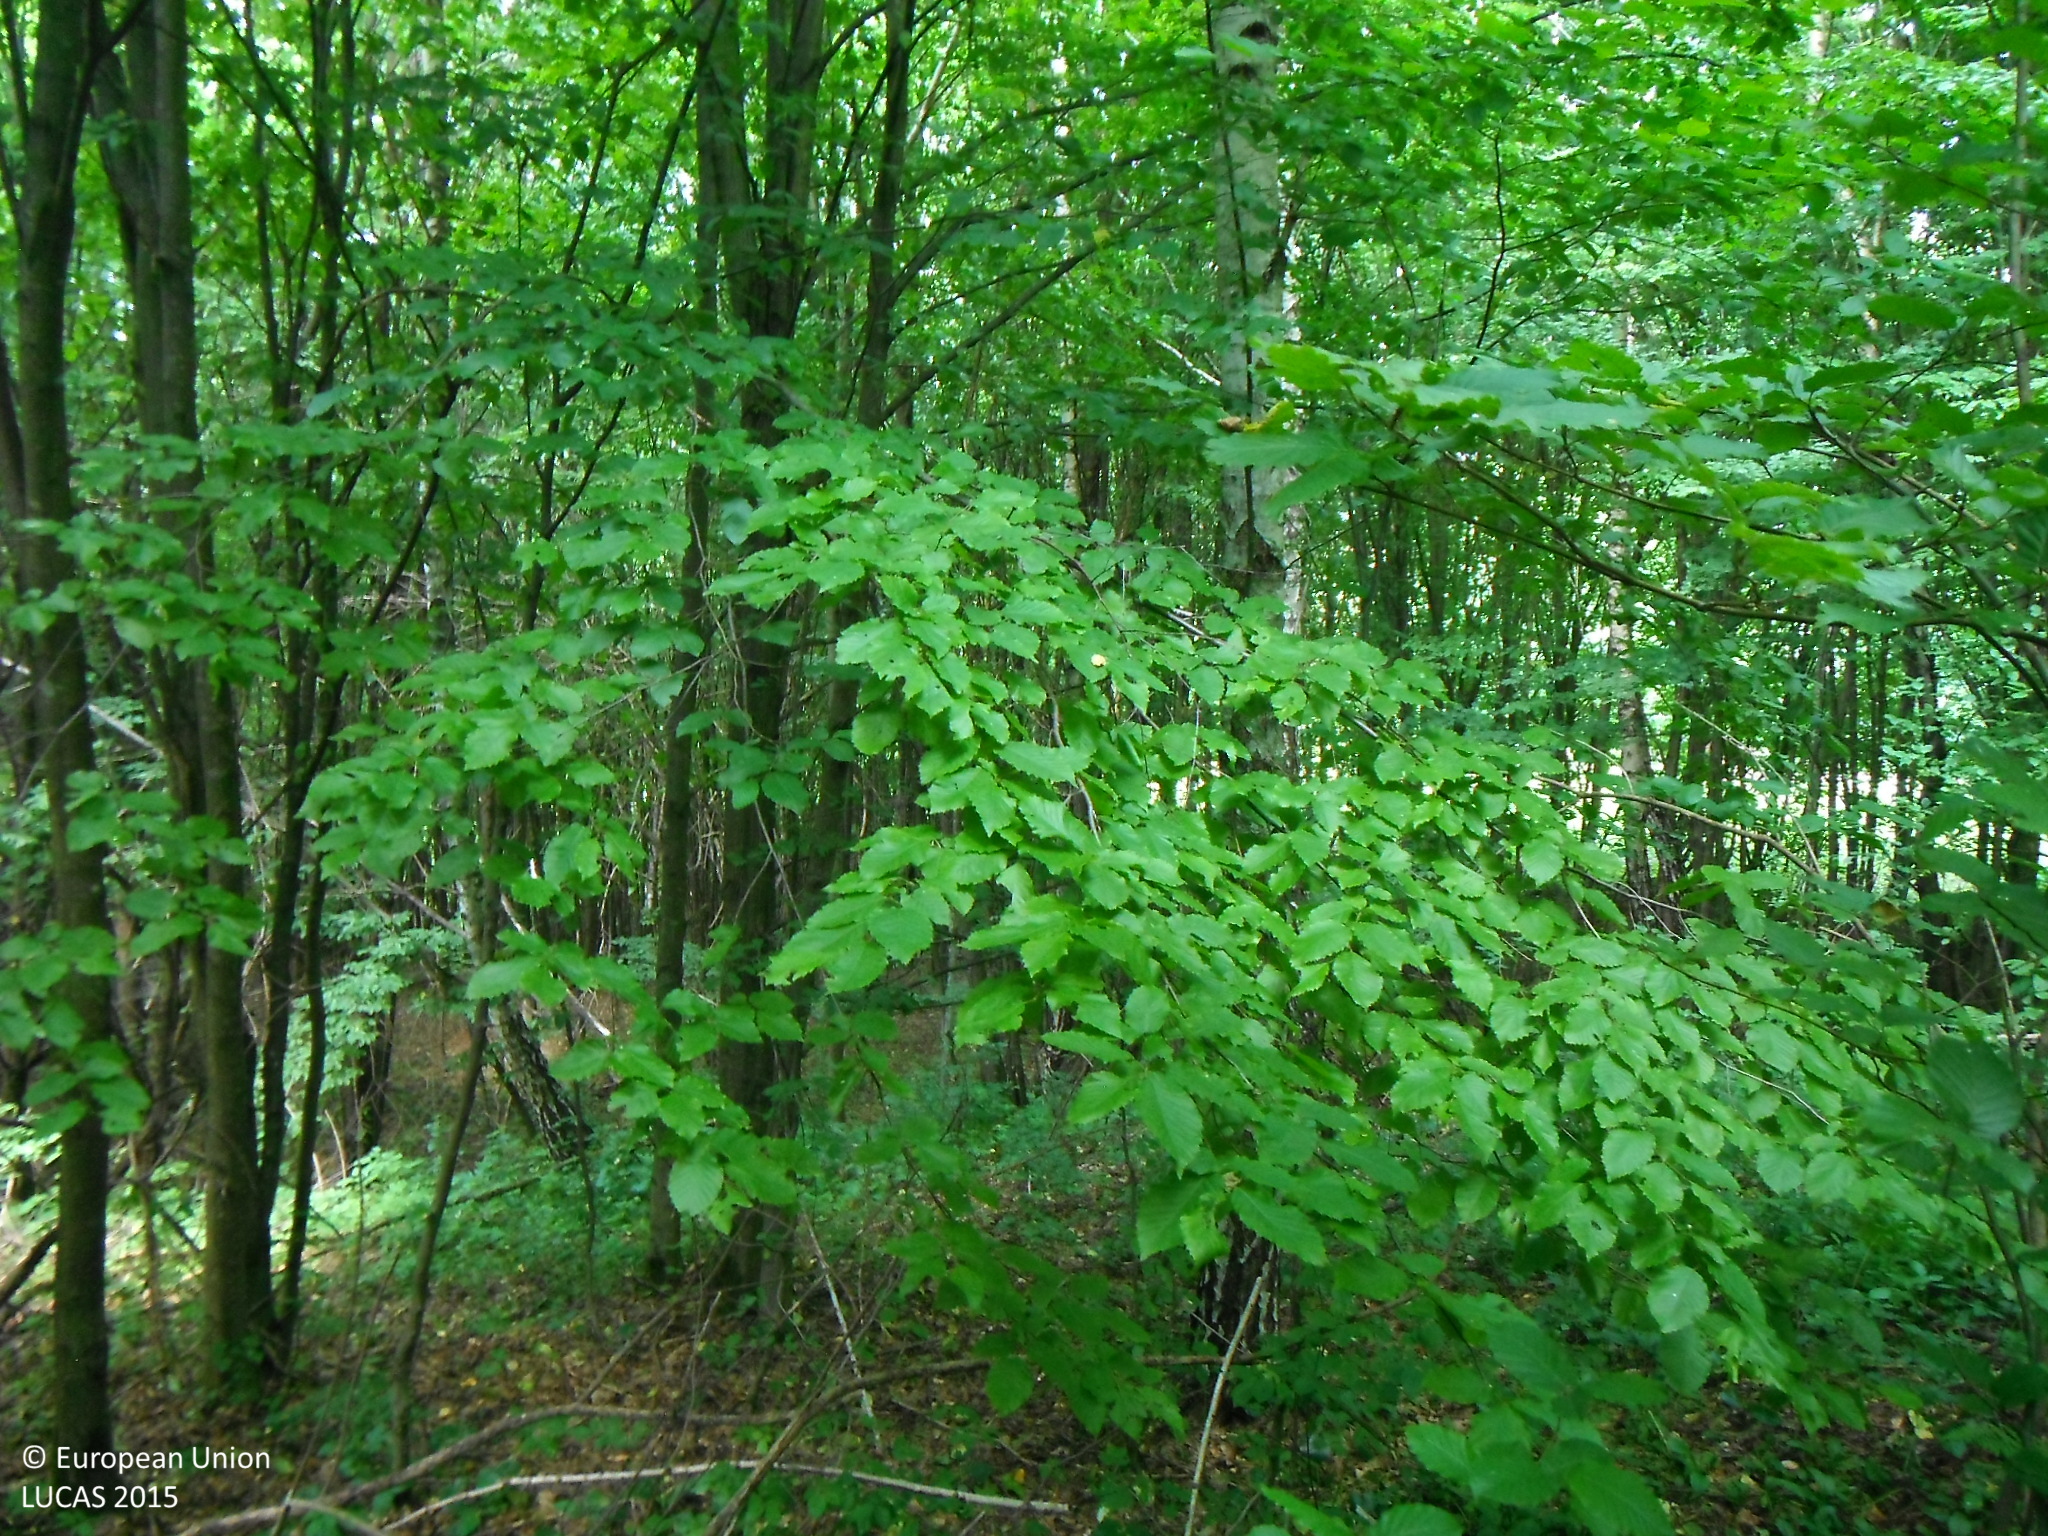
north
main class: Woodland
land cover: Broadleaved woodland
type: mesophytic deciduous forest
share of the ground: > 75 %
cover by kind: broadleaved forest trees 90 %, coniferous forest trees 10 %
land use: Forestry
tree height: > 5 m
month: July
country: SK
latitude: 49.1628
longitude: 22.0284
